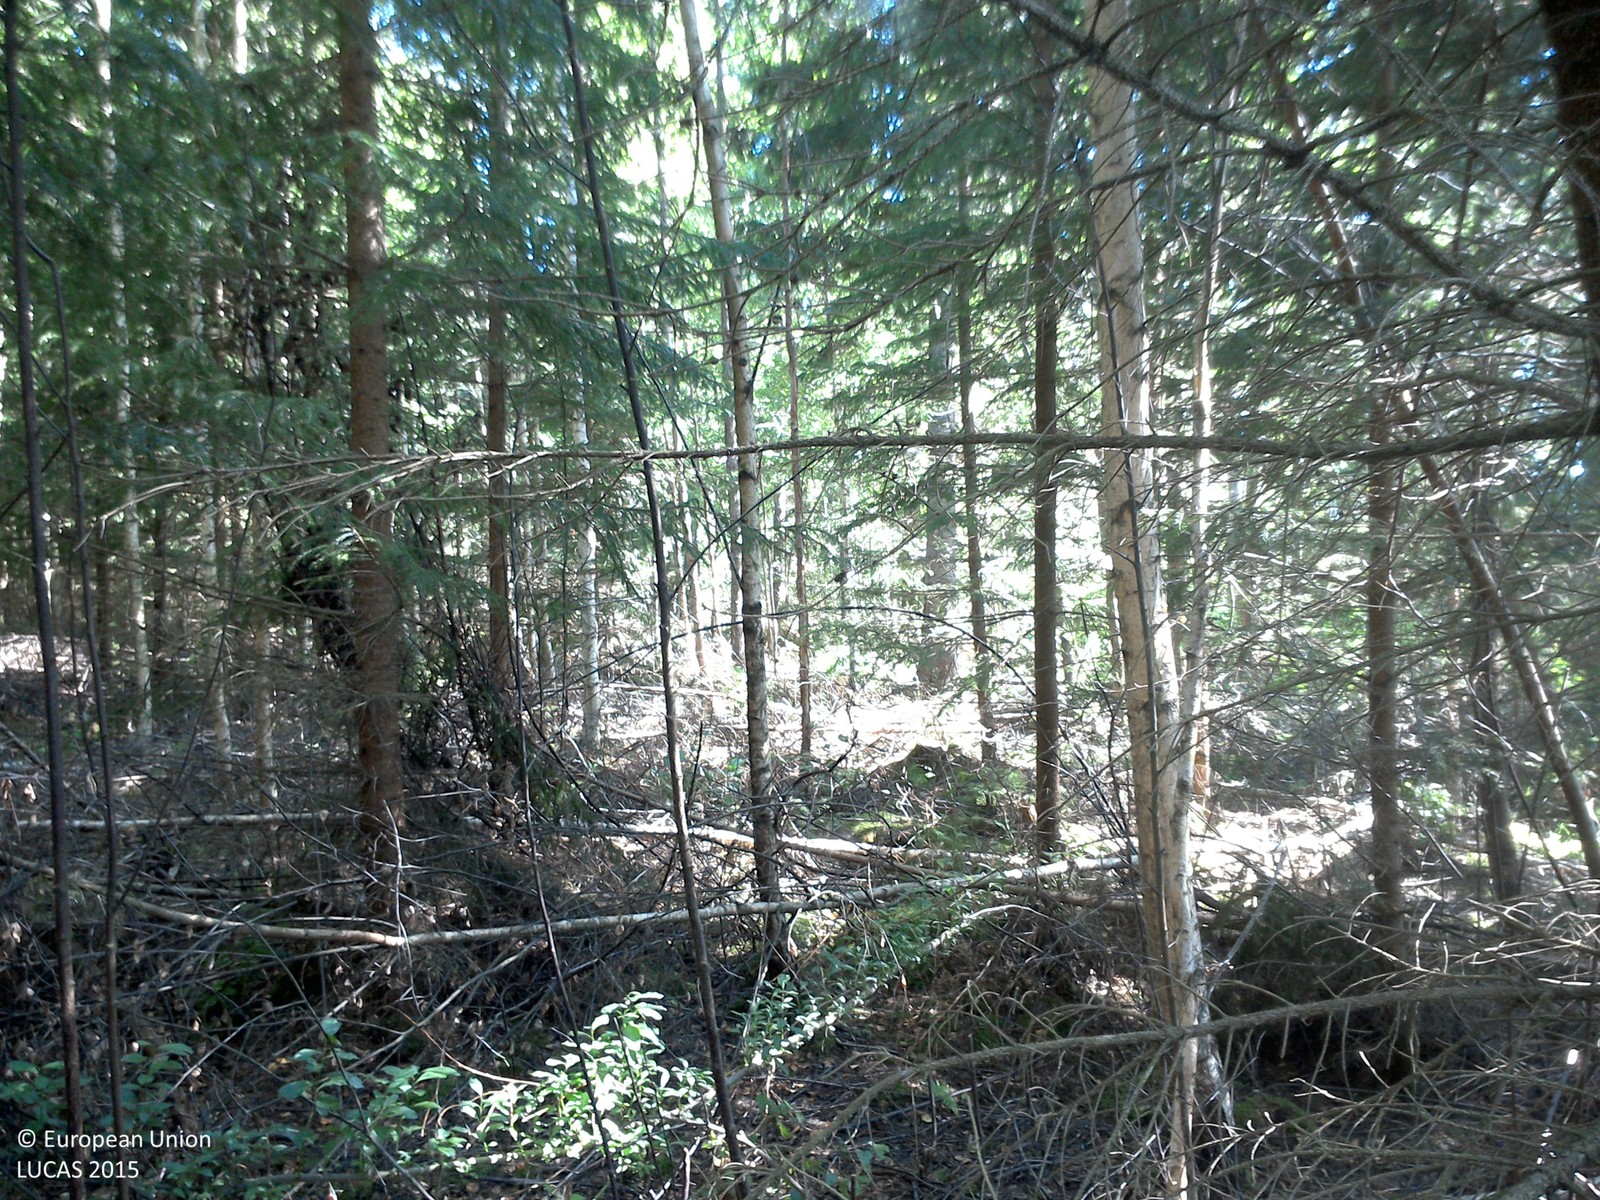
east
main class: Woodland
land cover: Spruce dominated mixed woodland
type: boreal forest
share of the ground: > 75 %
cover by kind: coniferous forest trees 55 %, broadleaved forest trees 20 %, lichens and mosses 15 %, herbaceous plants 10 %
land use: Forestry
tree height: > 5 m
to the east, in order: Spruce dominated mixed woodland; Grassland with sparse tree/shrub cover; Broadleaved woodland; Grassland with sparse tree/shrub cover; Shrubland with sparse tree cover; Tracks; Grassland with sparse tree/shrub cover; Groves; Temporary grasslands; Broadleaved woodland; Grassland without tree/shrub cover
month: August
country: SE
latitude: 57.9673
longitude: 15.3878
